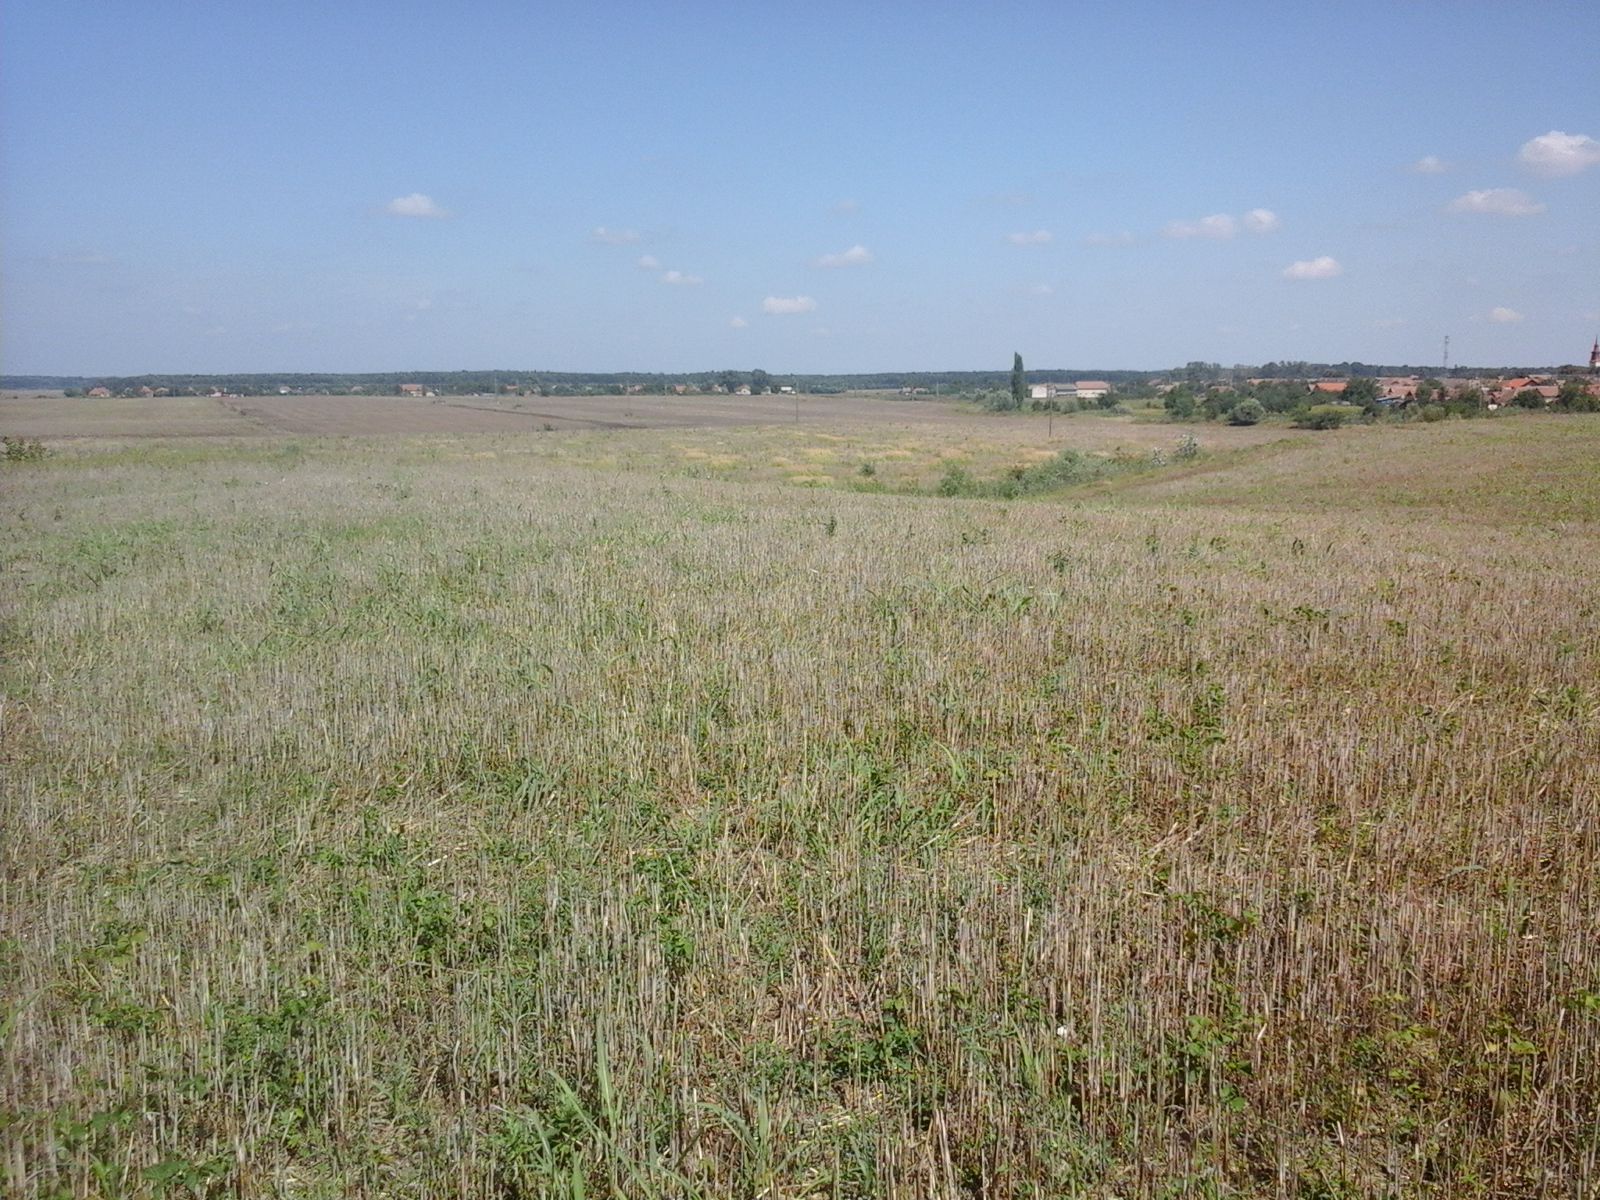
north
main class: Cropland
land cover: Common wheat
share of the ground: > 75 %
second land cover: Spontaneously vegetated surfaces
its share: > 75 %
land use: Agriculture (excluding fallow land and kitchen gardens)
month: August
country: RO
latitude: 46.1050
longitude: 21.0396
